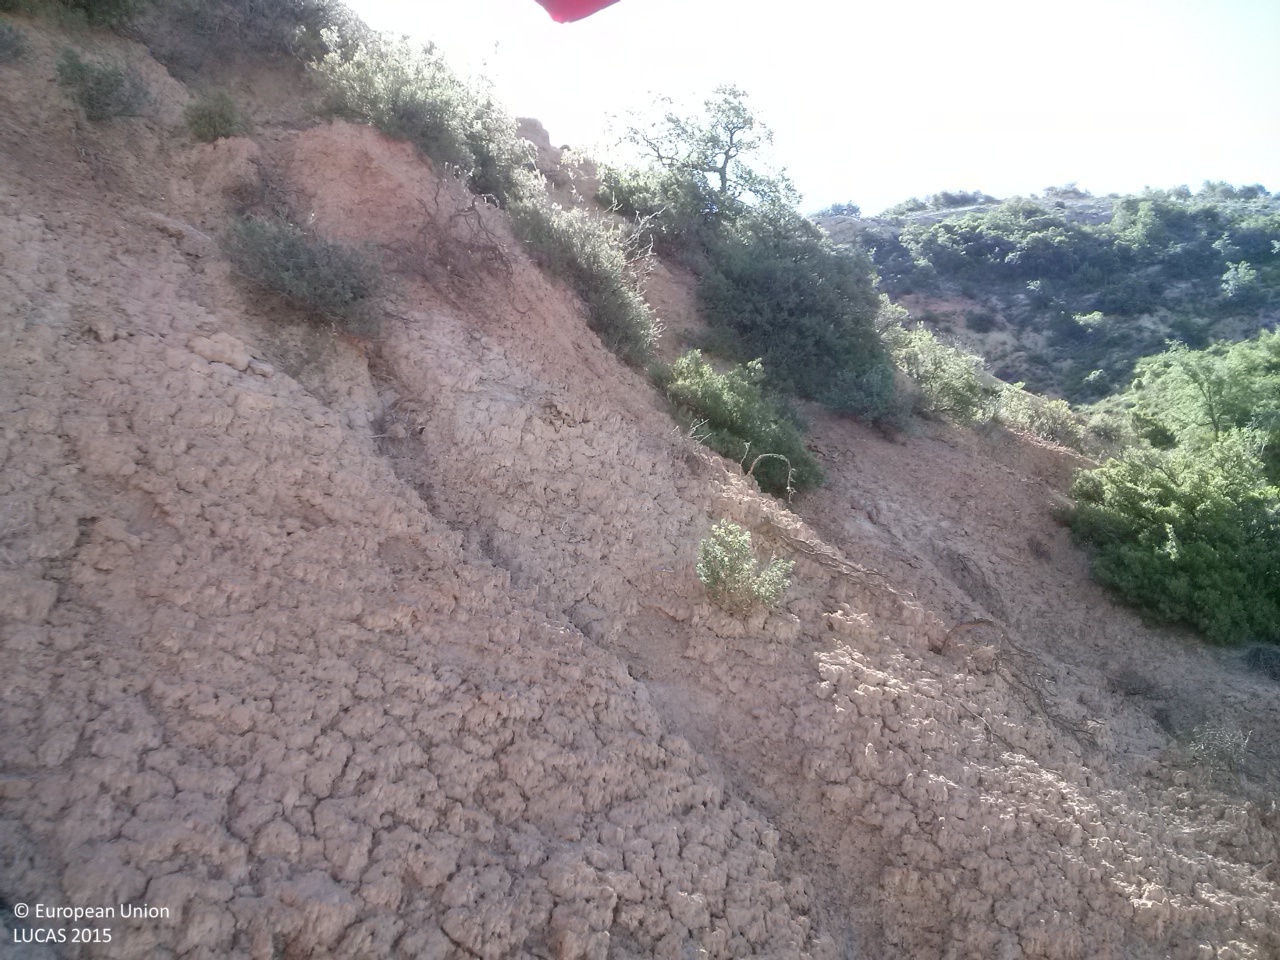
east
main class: Shrubland
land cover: Shrubland with sparse tree cover
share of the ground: 10 - 25 %
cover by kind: unconsolidated bare surface 75 %, shrubs 20 %, coniferous forest trees 5 %
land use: Agriculture (excluding fallow land and kitchen gardens)
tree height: > 5 m
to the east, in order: Shrubland with sparse tree cover; Rock outcrops; Shrubland without tree cover; Shrubland with sparse tree cover; Broadleaved woodland
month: May
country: ES
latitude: 40.3345
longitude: -2.5590
